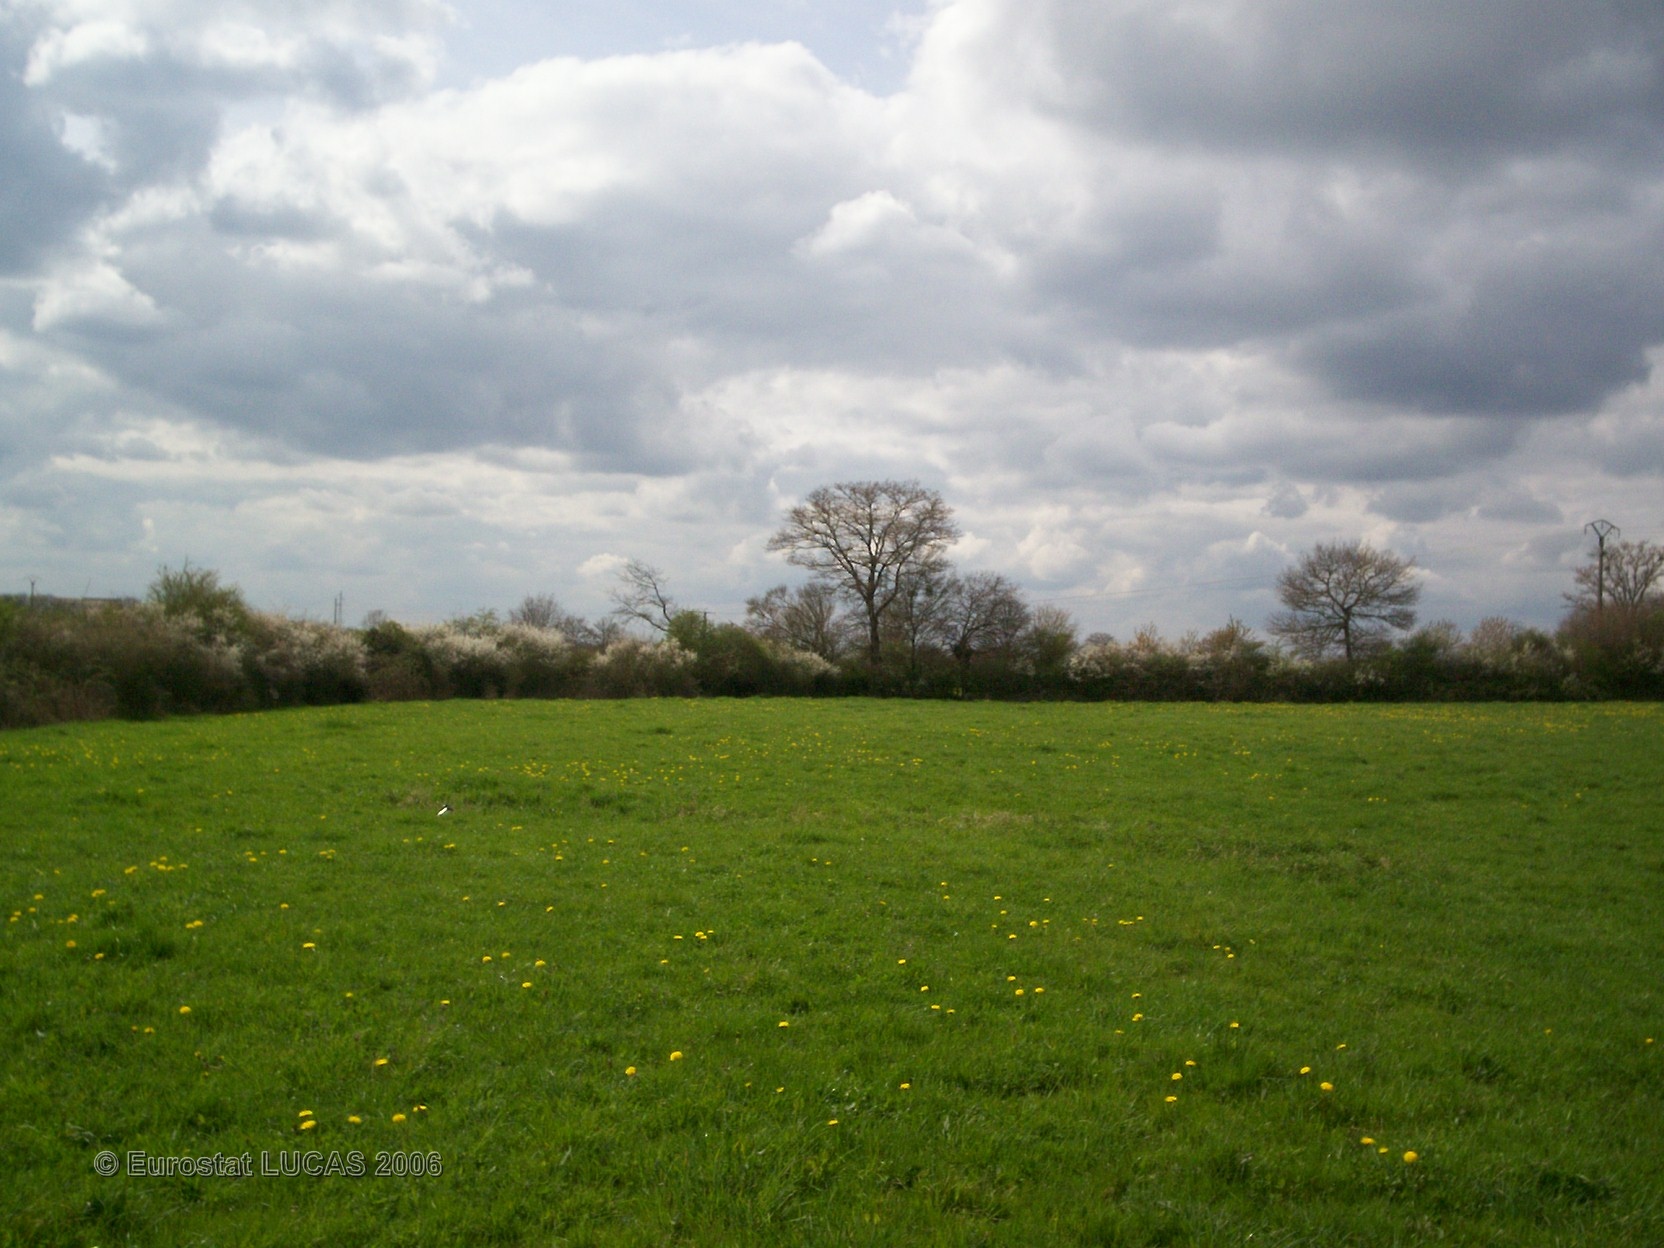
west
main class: Grassland
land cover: Grassland without tree/shrub cover
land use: Agriculture (excluding fallow land and kitchen gardens)
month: April
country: FR
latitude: 47.9116
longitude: -0.5904
